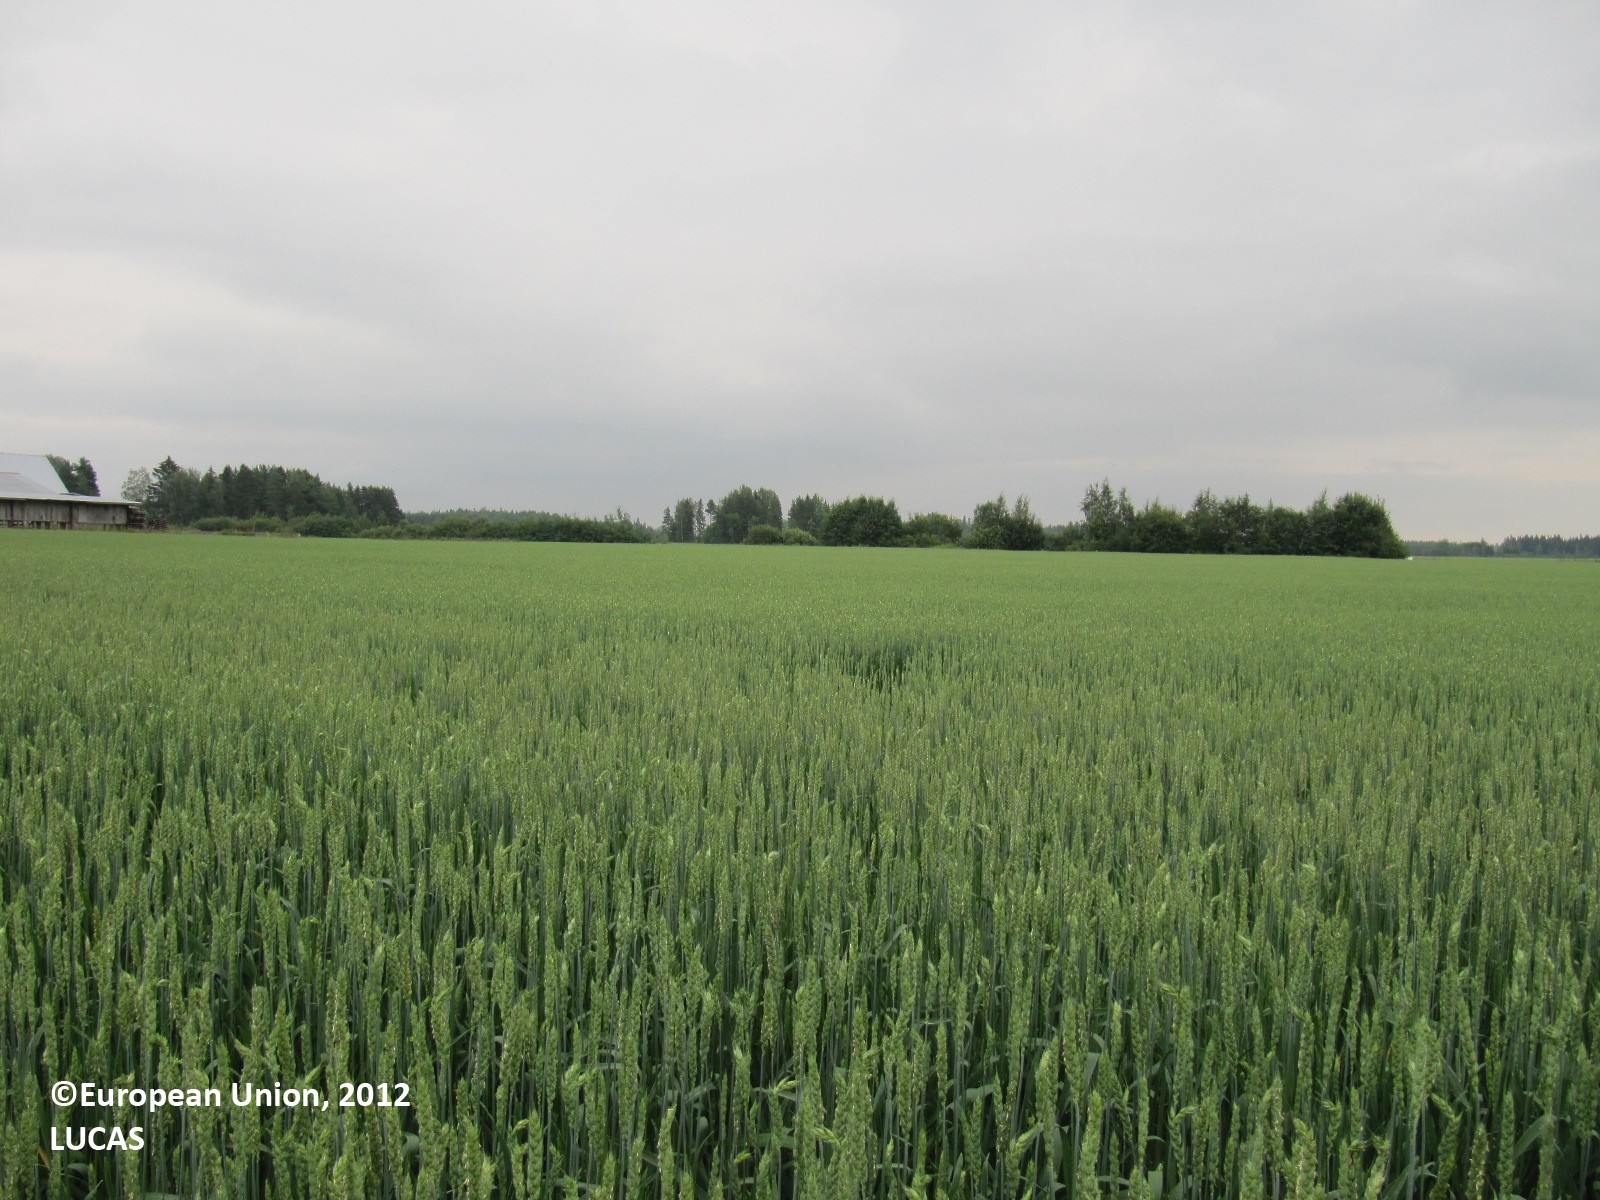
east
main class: Cropland
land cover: Common wheat
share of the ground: > 75 %
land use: Agriculture (excluding fallow land and kitchen gardens)
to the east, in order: Common wheat; Broadleaved woodland; Ditches and canals; Common wheat
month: July
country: FI
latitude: 60.6976
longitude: 23.3255
